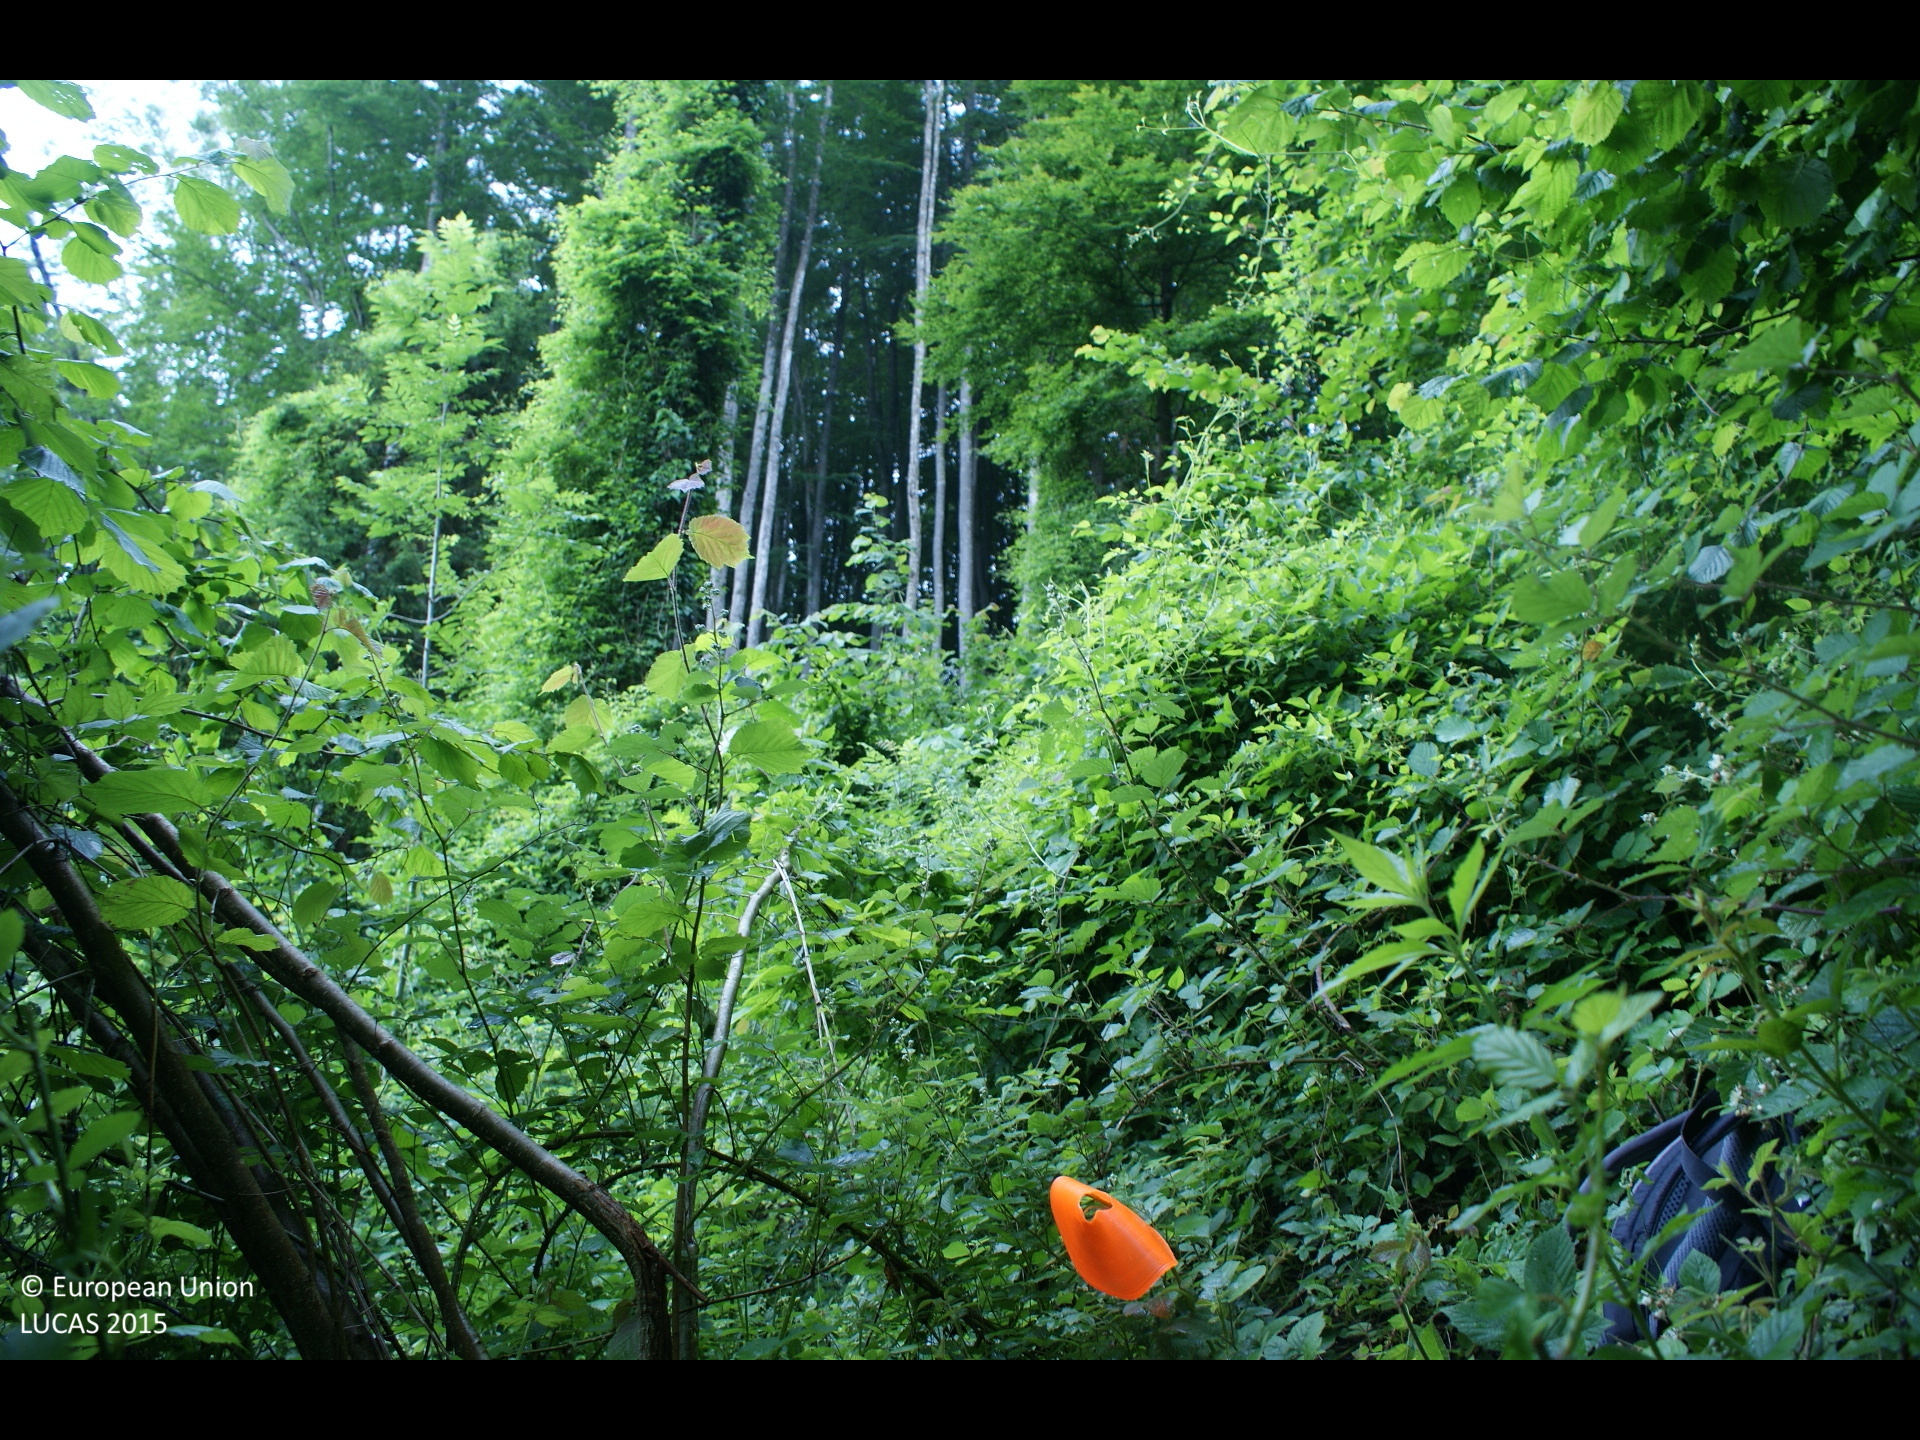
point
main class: Shrubland
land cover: Shrubland with sparse tree cover
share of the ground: > 75 %
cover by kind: shrubs 75 %, herbaceous plants 20 %, broadleaved forest trees 5 %
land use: Forestry
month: June
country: AT
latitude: 47.9553
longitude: 14.4055
